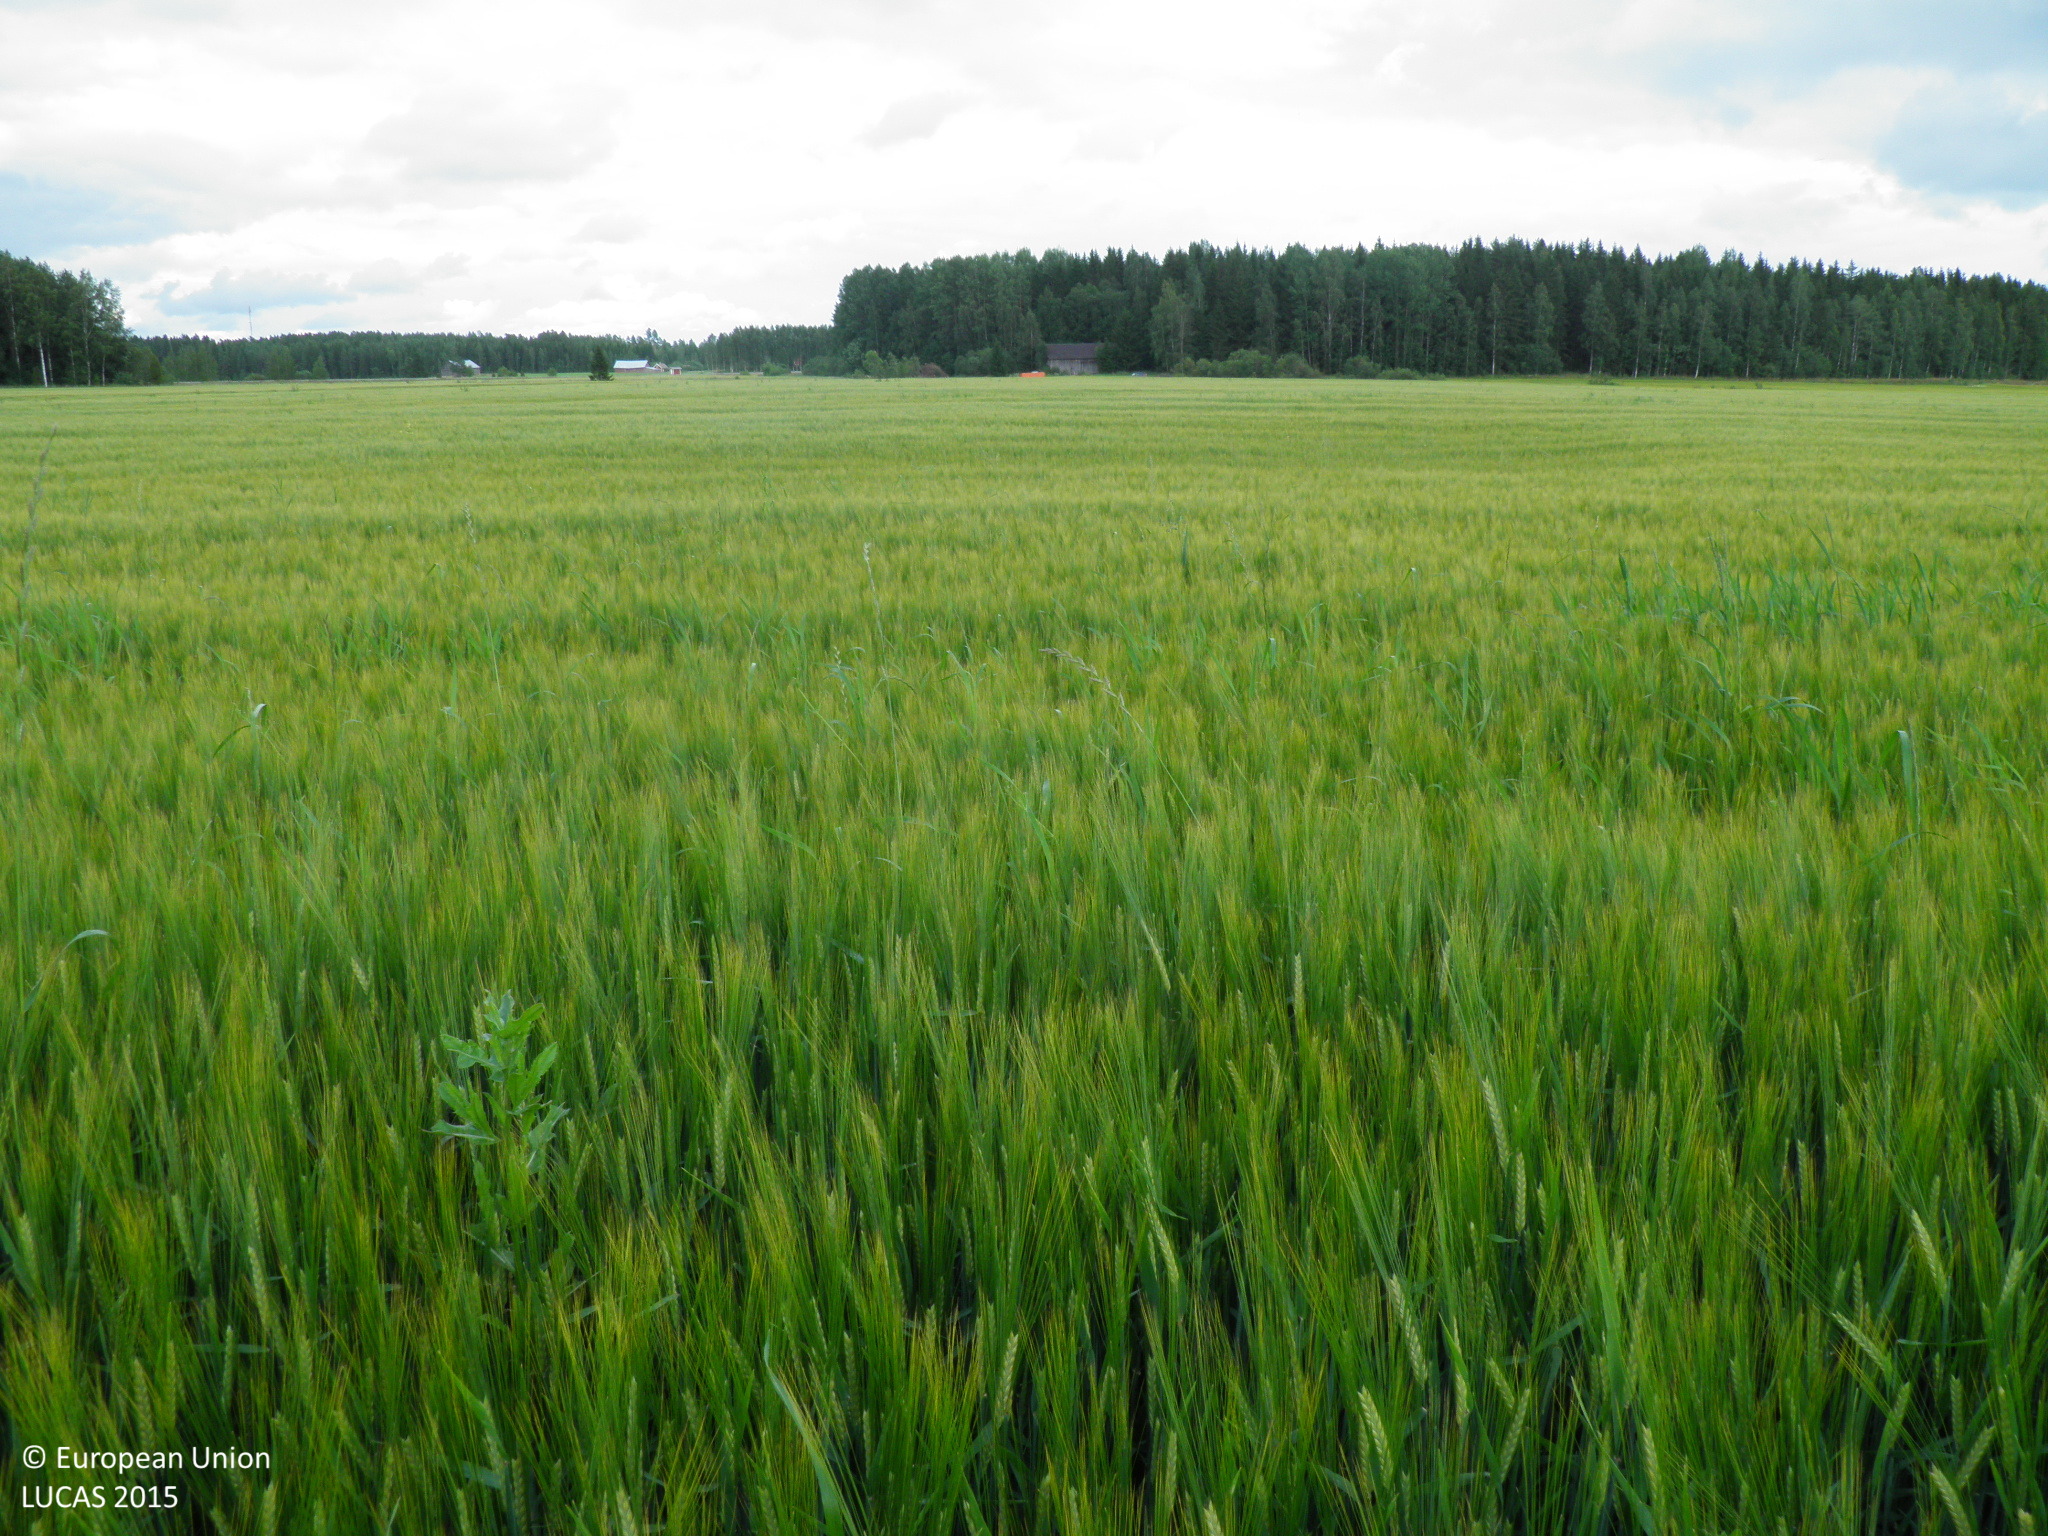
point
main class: Cropland
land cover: Barley
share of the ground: > 75 %
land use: Agriculture (excluding fallow land and kitchen gardens)
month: July
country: FI
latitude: 60.9447
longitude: 22.8273
